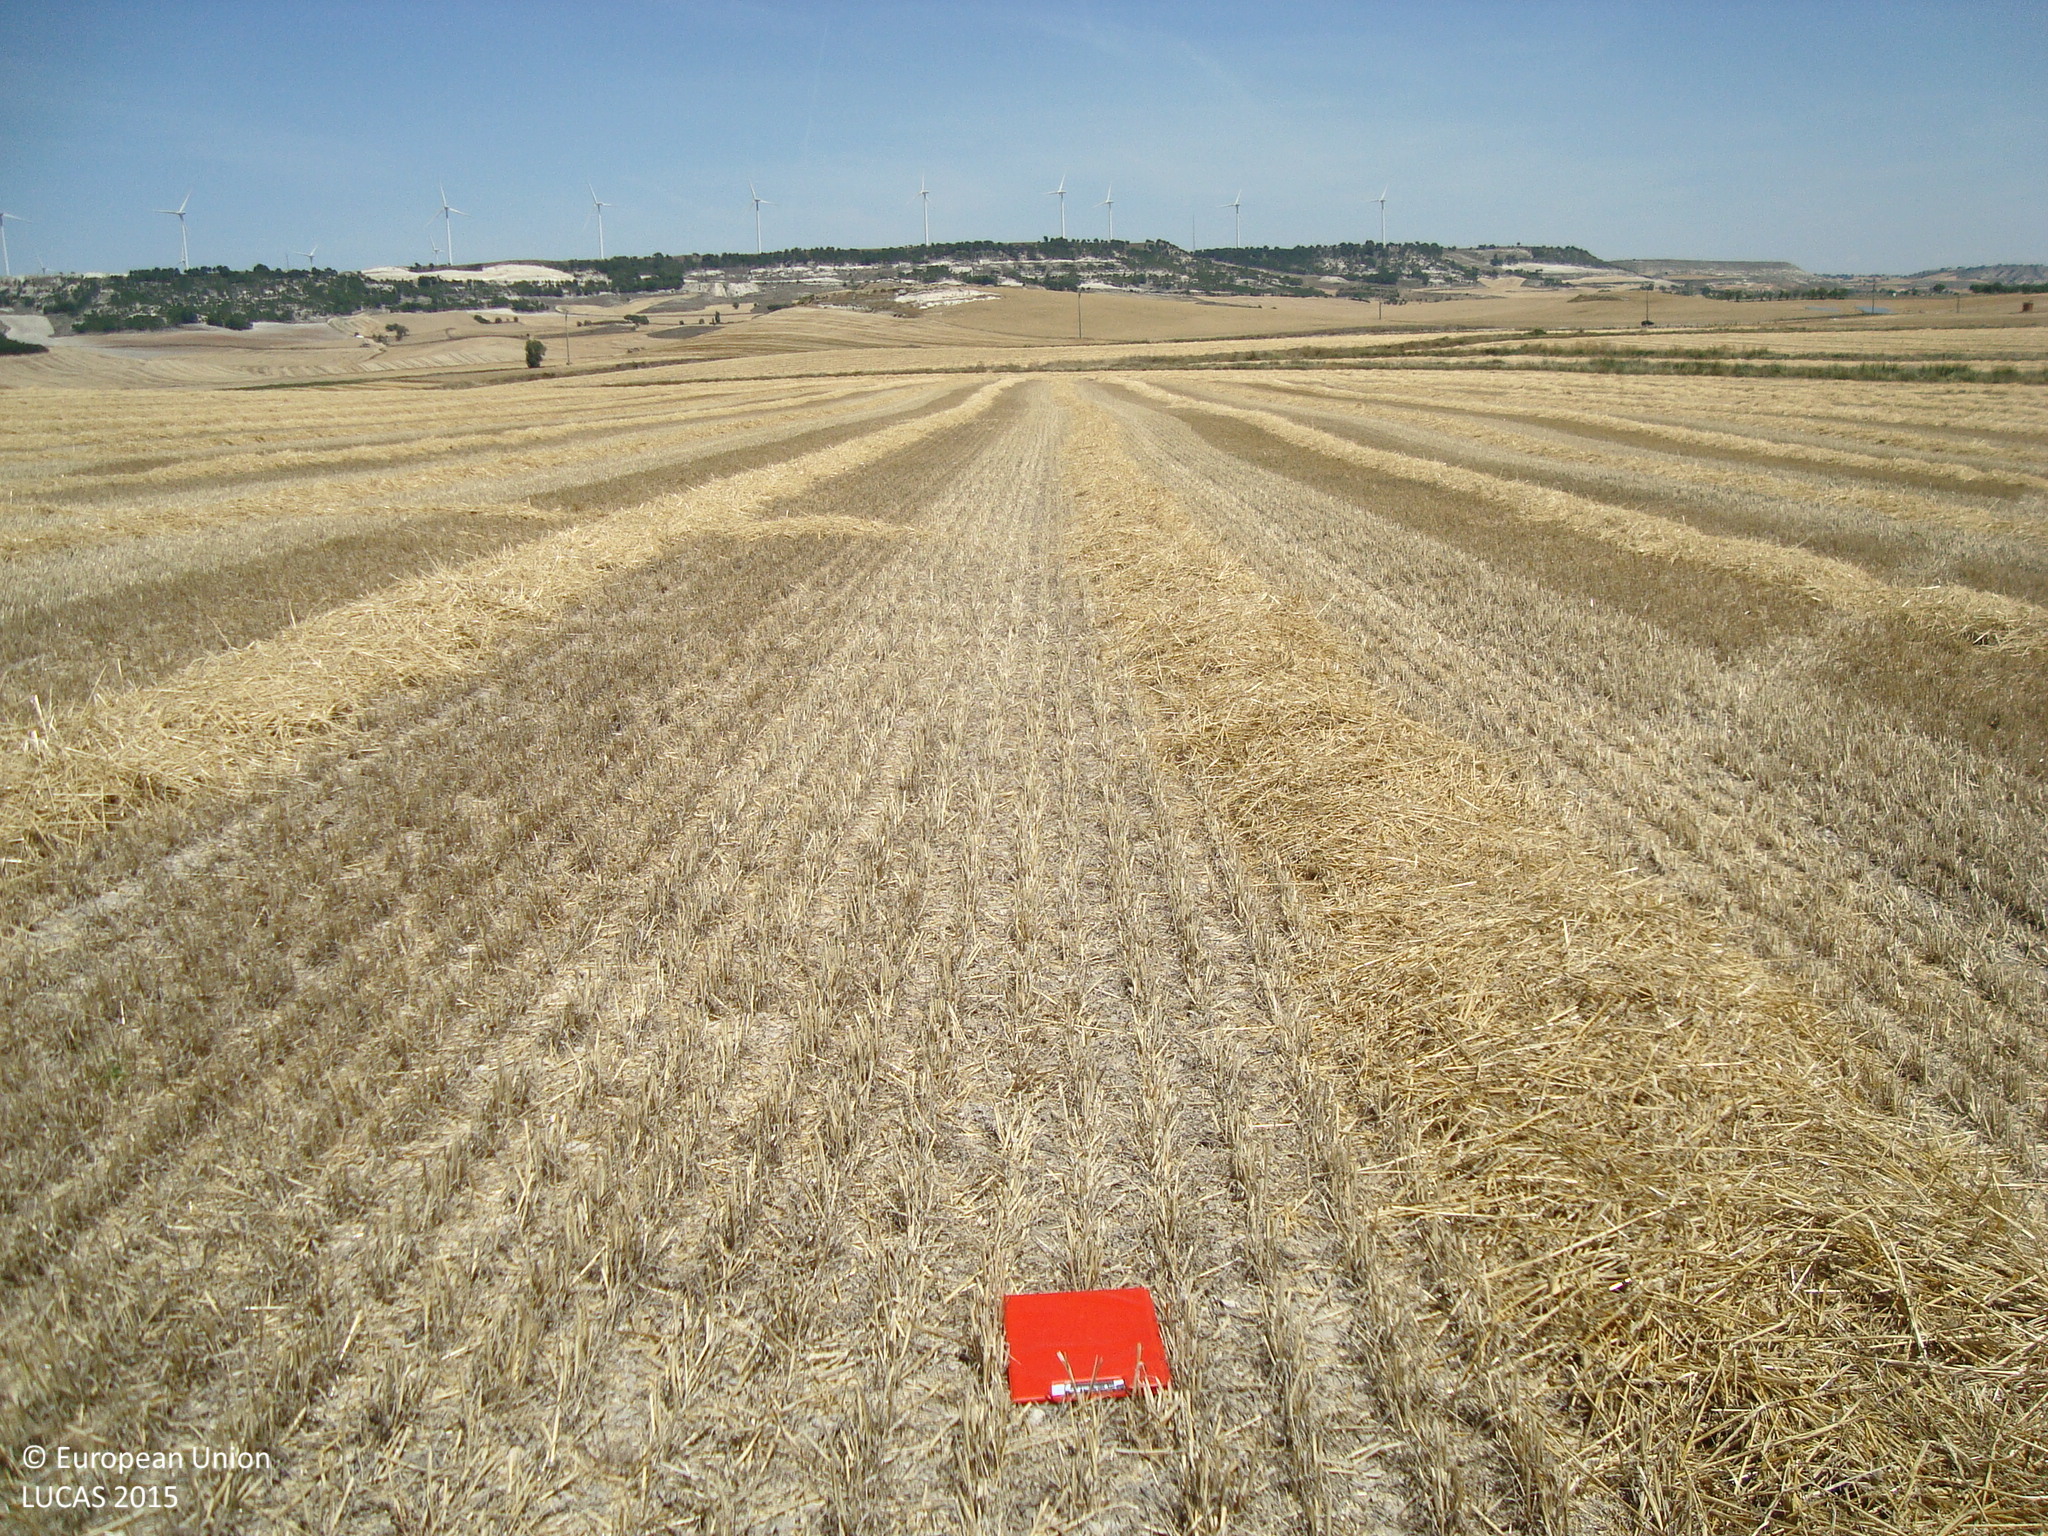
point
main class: Cropland
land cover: Common wheat
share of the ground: < 10 %
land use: Agriculture (excluding fallow land and kitchen gardens)
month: July
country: ES
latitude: 41.9466
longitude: -4.2872
